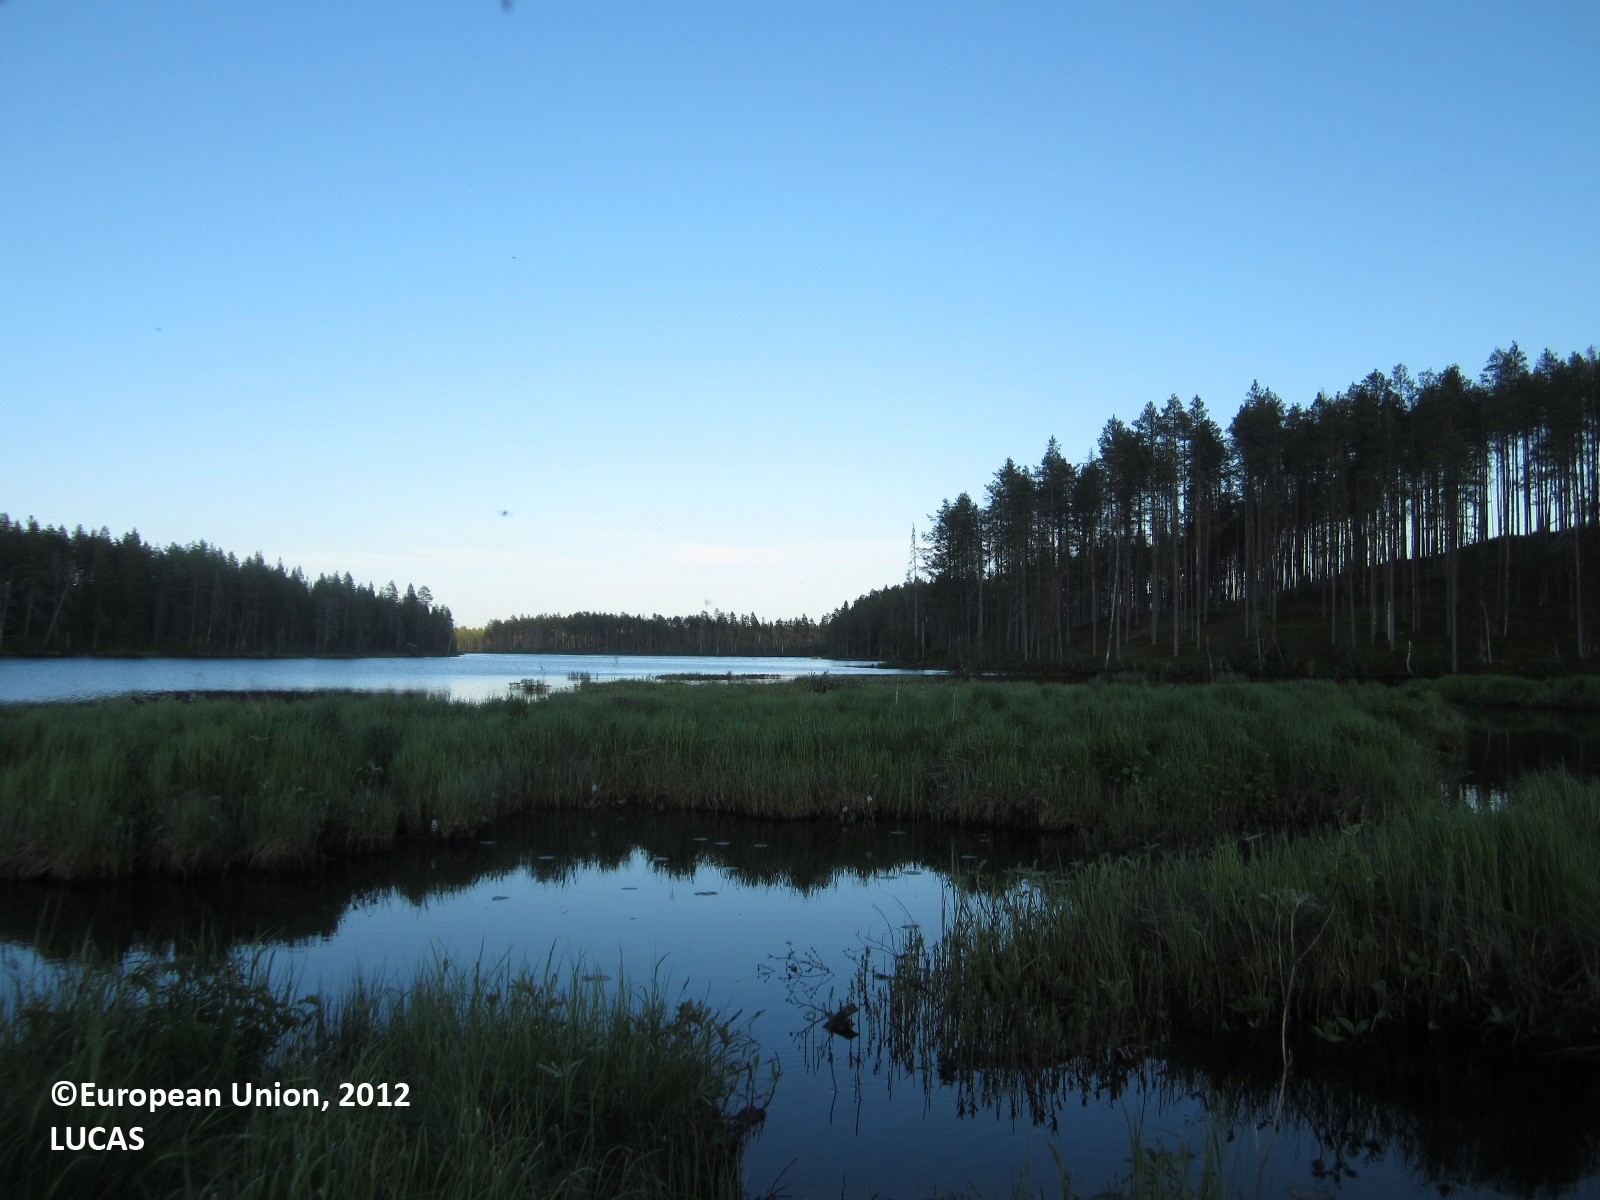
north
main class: Woodland
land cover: Pine dominated coniferous woodland
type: boreal forest
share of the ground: > 75 %
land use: Forestry
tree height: > 5 m
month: June
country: FI
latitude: 64.8277
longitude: 29.2689
